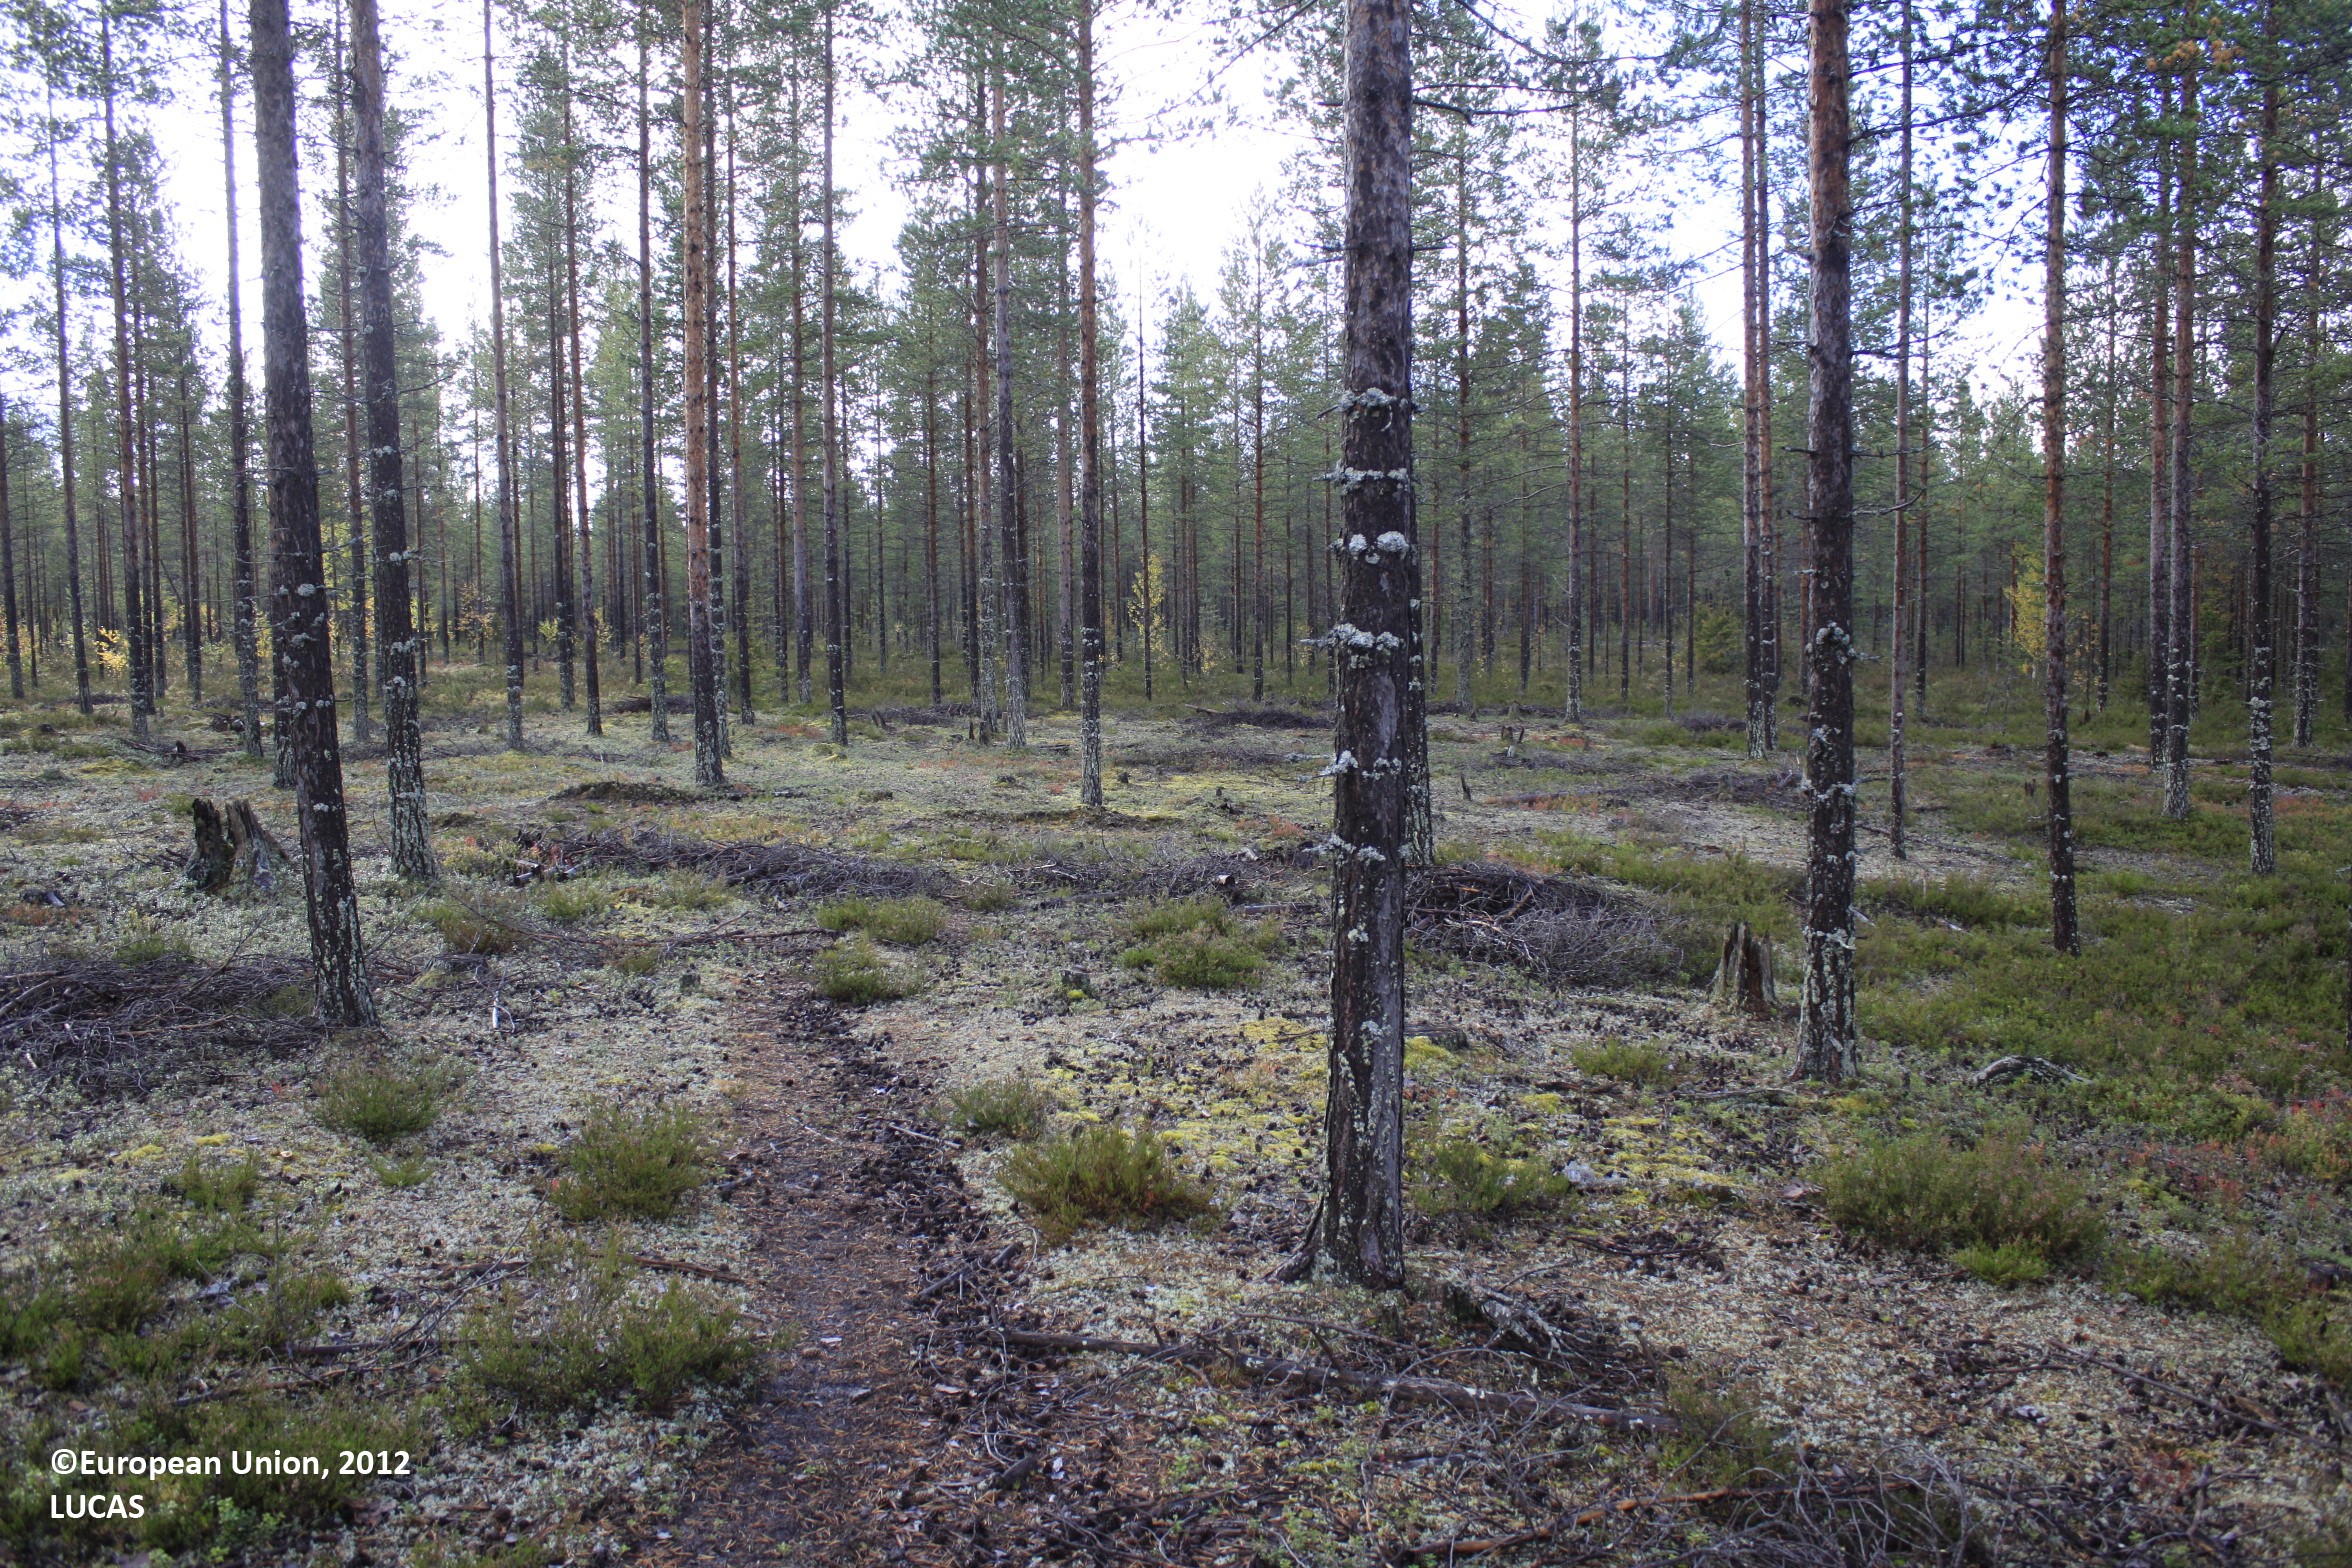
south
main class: Woodland
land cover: Pine dominated coniferous woodland
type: boreal forest
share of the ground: 25 - 50 %
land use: Forestry
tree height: > 5 m
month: September
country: FI
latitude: 65.5710
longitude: 27.3516
